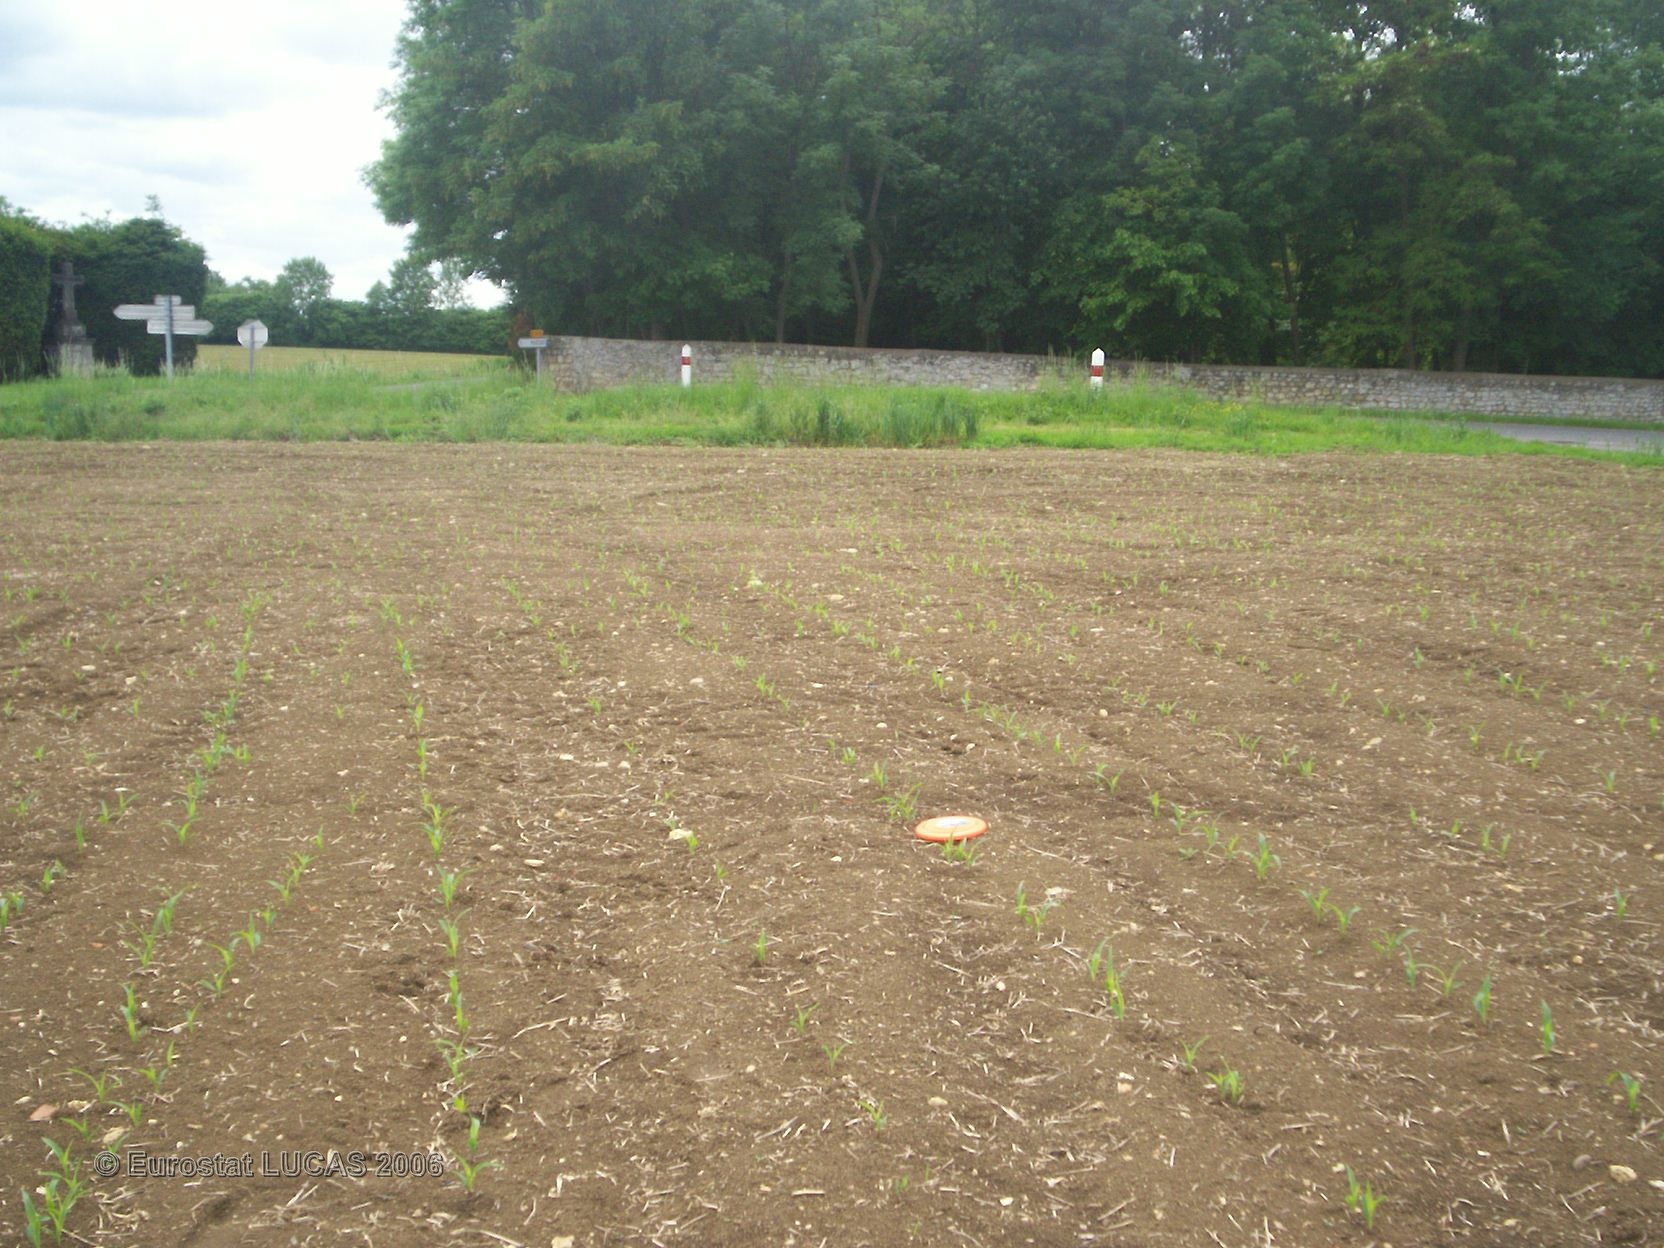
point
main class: Cropland
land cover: Maize
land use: Agriculture (excluding fallow land and kitchen gardens)
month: May
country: FR
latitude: 46.0828
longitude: 3.2359
